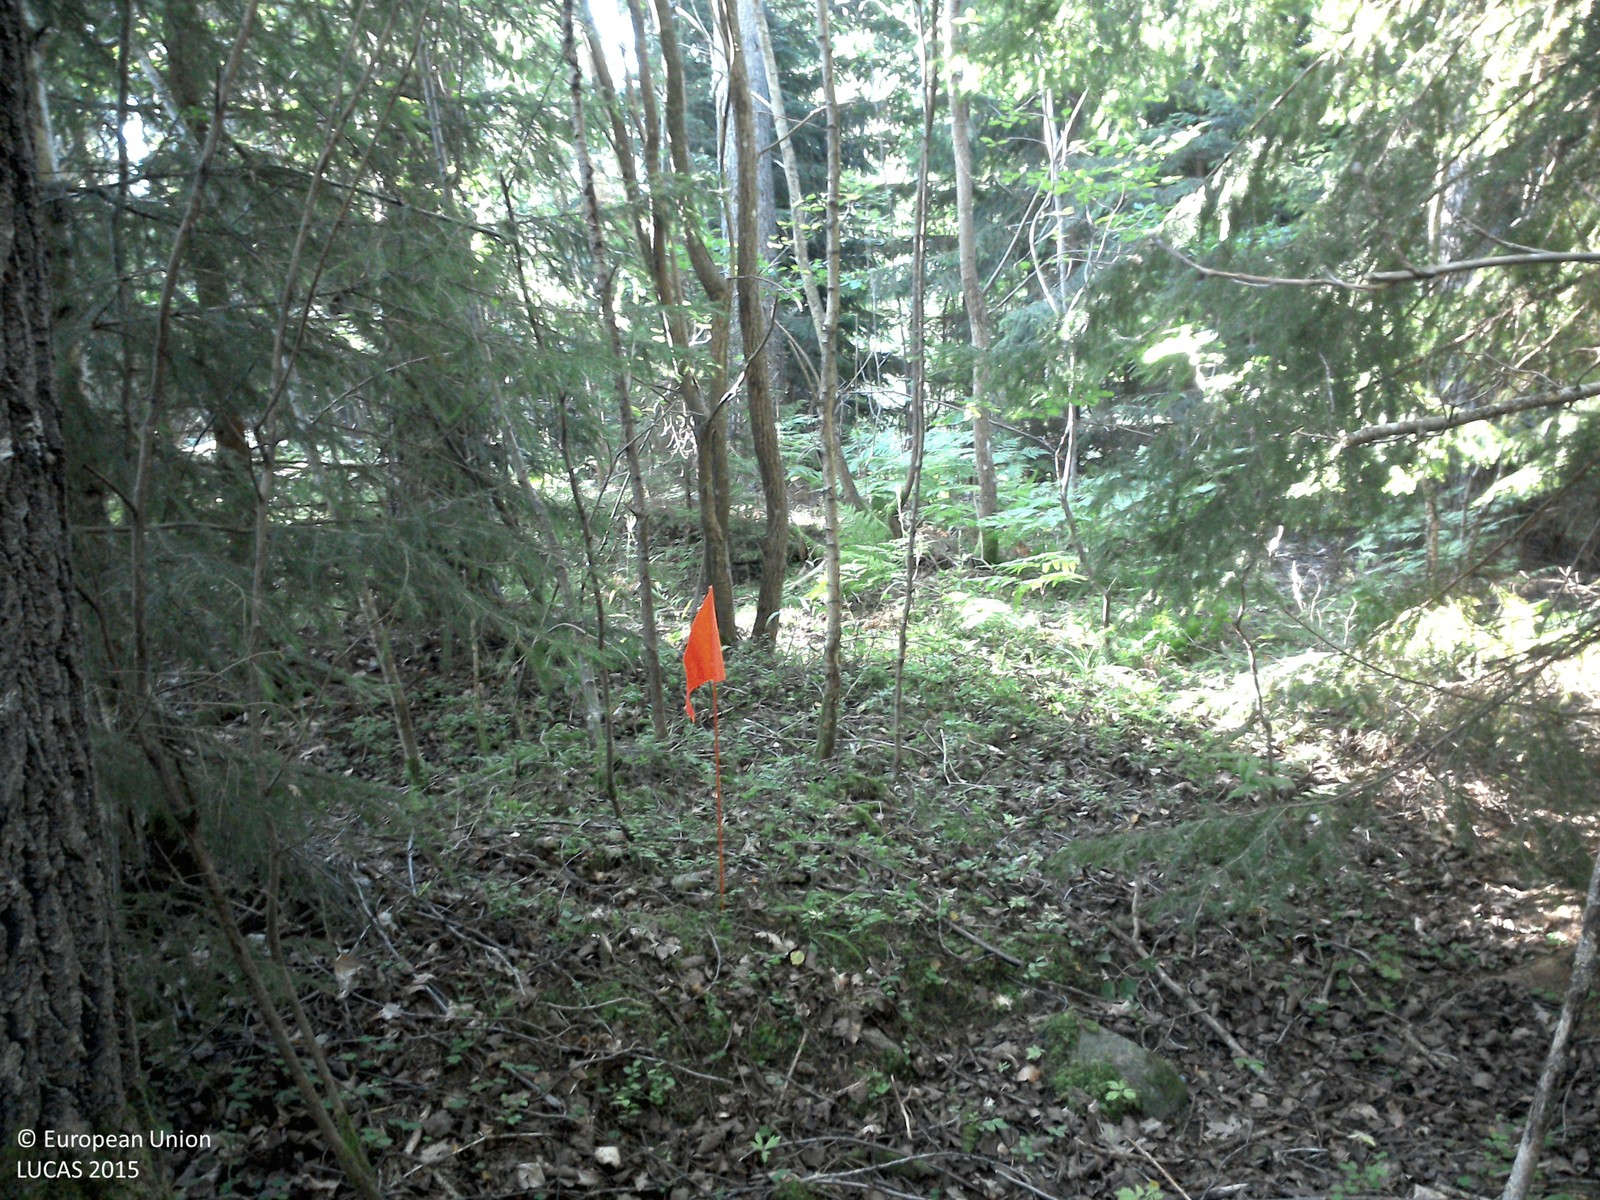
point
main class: Woodland
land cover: Pine dominated mixed woodland
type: boreal forest
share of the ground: > 75 %
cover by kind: coniferous forest trees 50 %, broadleaved forest trees 25 %, herbaceous plants 15 %, unconsolidated bare surface 10 %
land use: Forestry
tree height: > 5 m
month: July
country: SE
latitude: 58.2595
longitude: 15.2949
